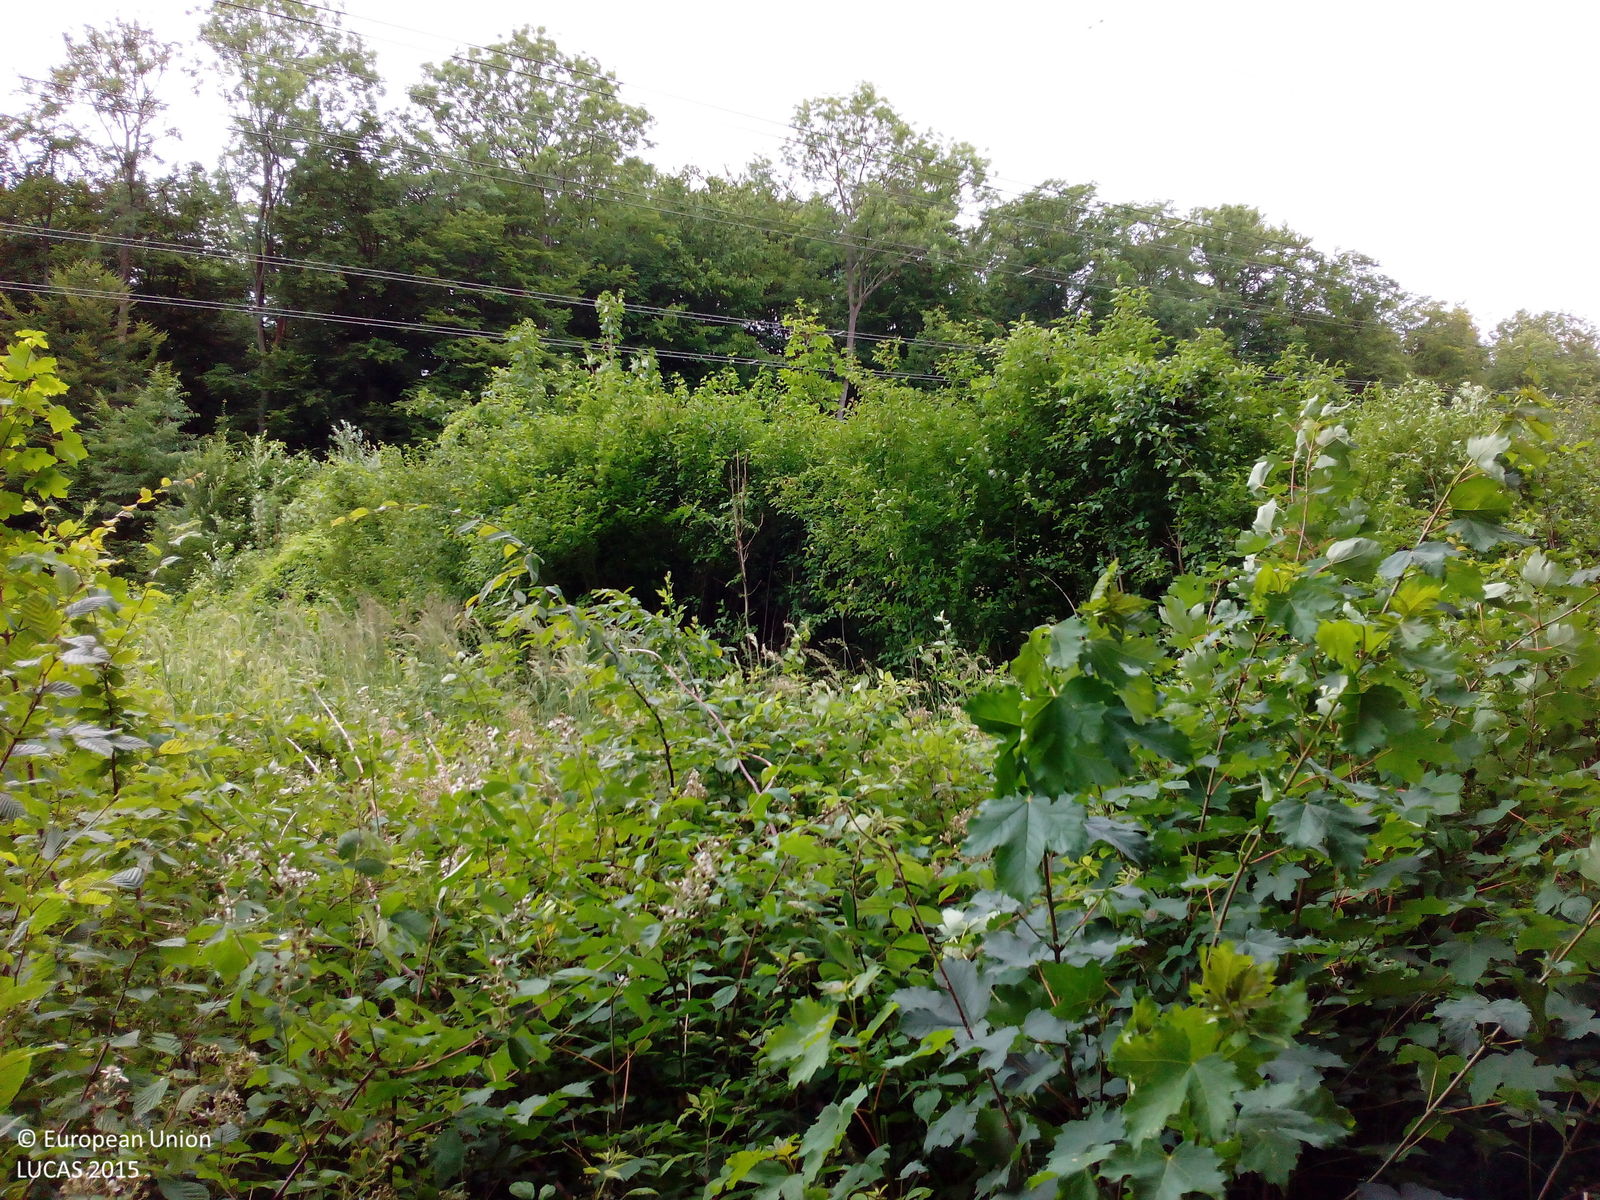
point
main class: Artificial land
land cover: Other artificial areas
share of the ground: > 75 %
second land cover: Shrubland with sparse tree cover
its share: > 75 %
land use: Electricity, gas and thermal power distribution
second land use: Forestry
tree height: > 5 m
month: July
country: DE
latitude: 51.5686
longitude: 9.9567
